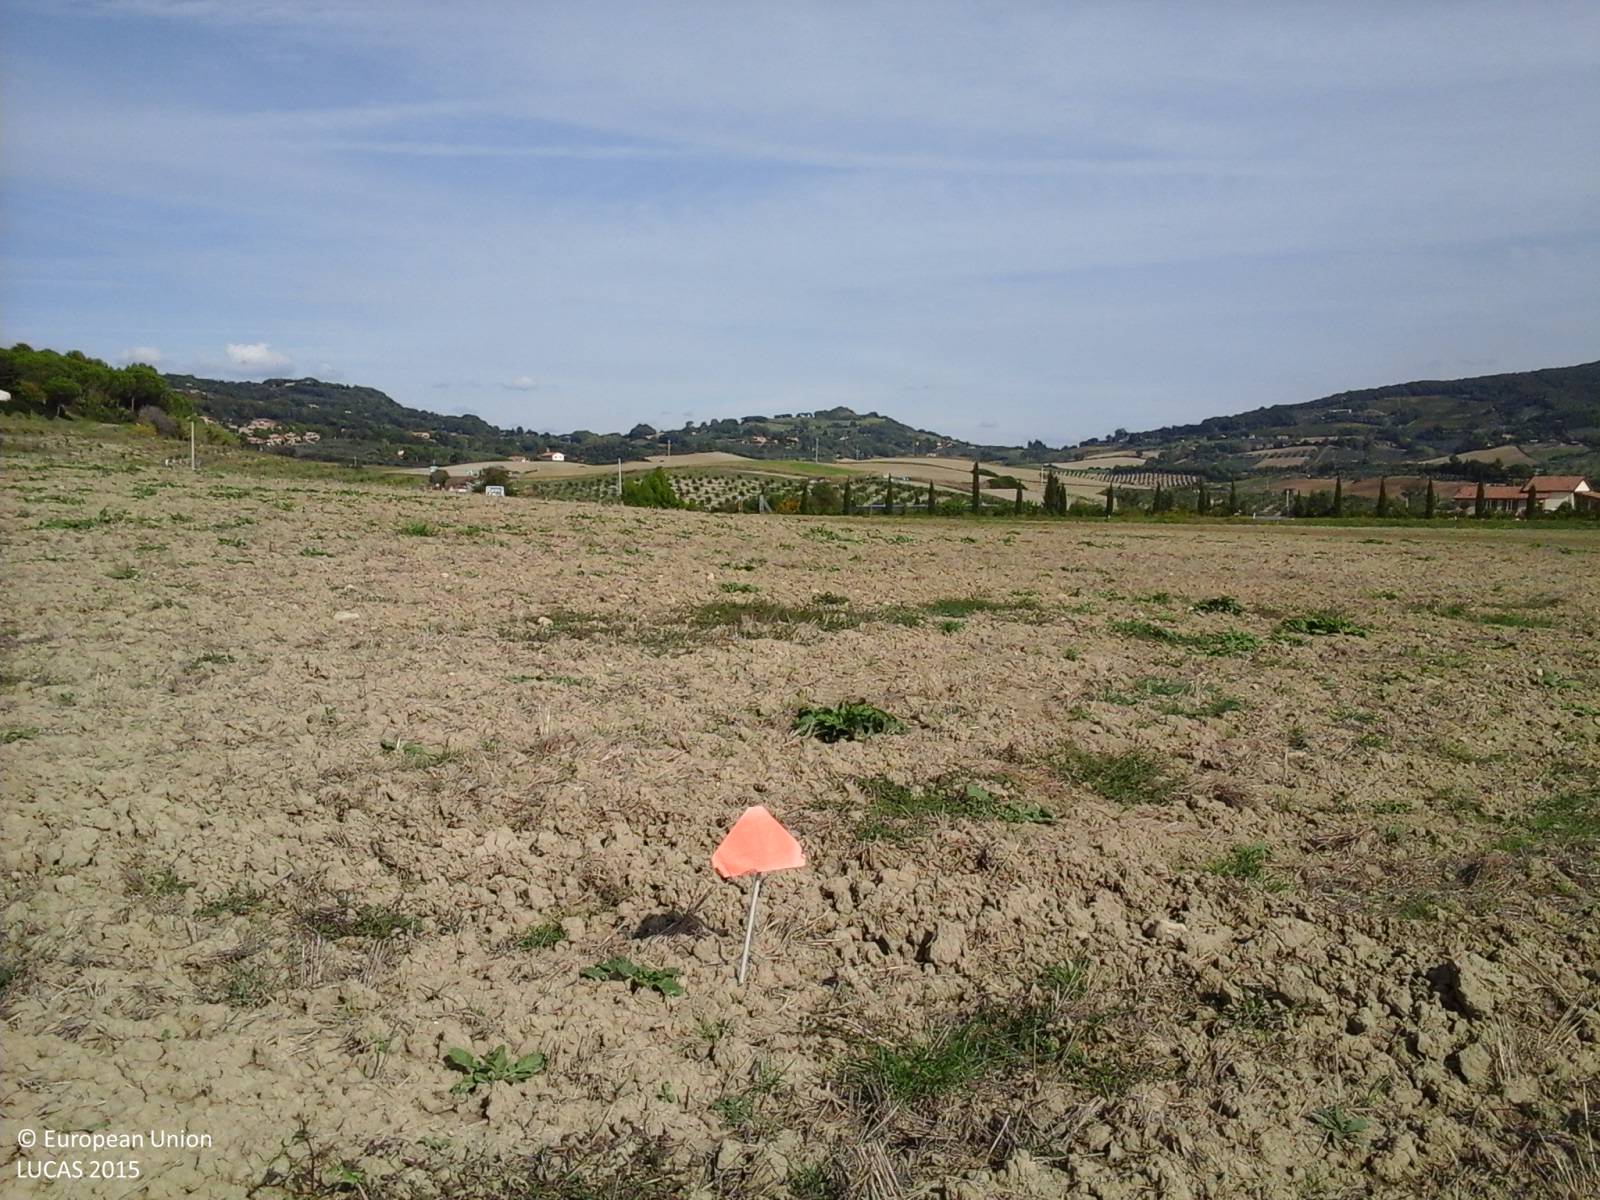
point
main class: Cropland
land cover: Durum wheat
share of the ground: < 10 %
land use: Agriculture (excluding fallow land and kitchen gardens)
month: October
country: IT
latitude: 43.2842
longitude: 10.6021
